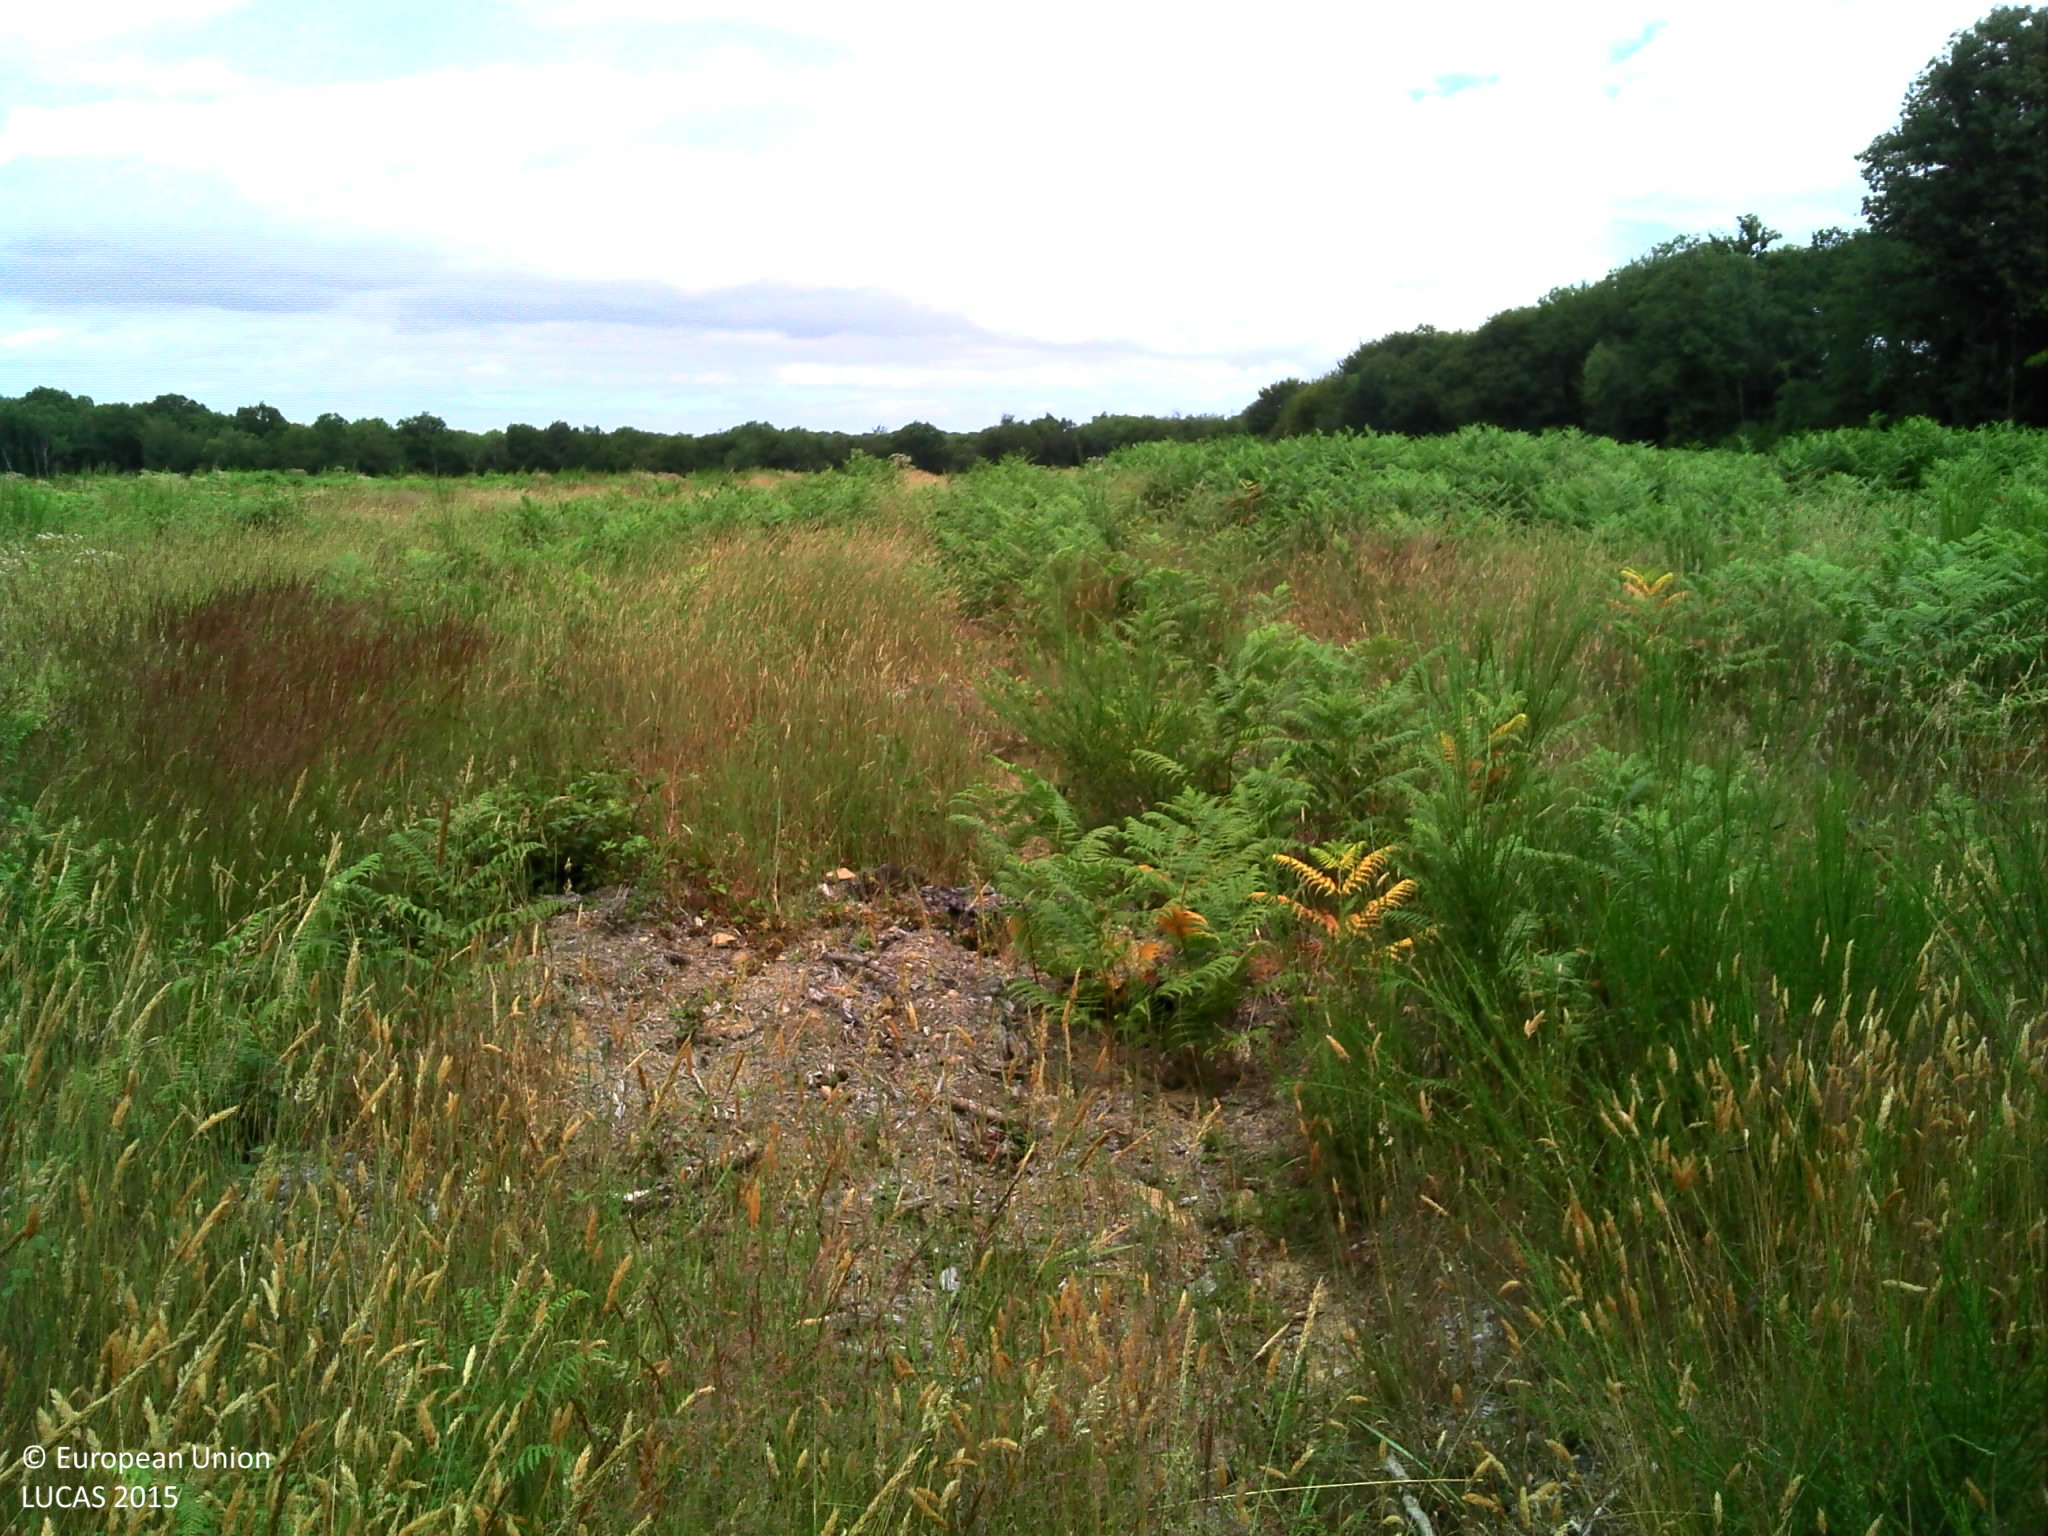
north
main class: Grassland
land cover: Spontaneously vegetated surfaces
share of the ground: > 75 %
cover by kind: herbaceous plants 75 %, unconsolidated bare surface 20 %, shrubs 5 %
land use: Forestry
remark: Clear cut
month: July
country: FR
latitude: 48.4335
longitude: -2.3725
